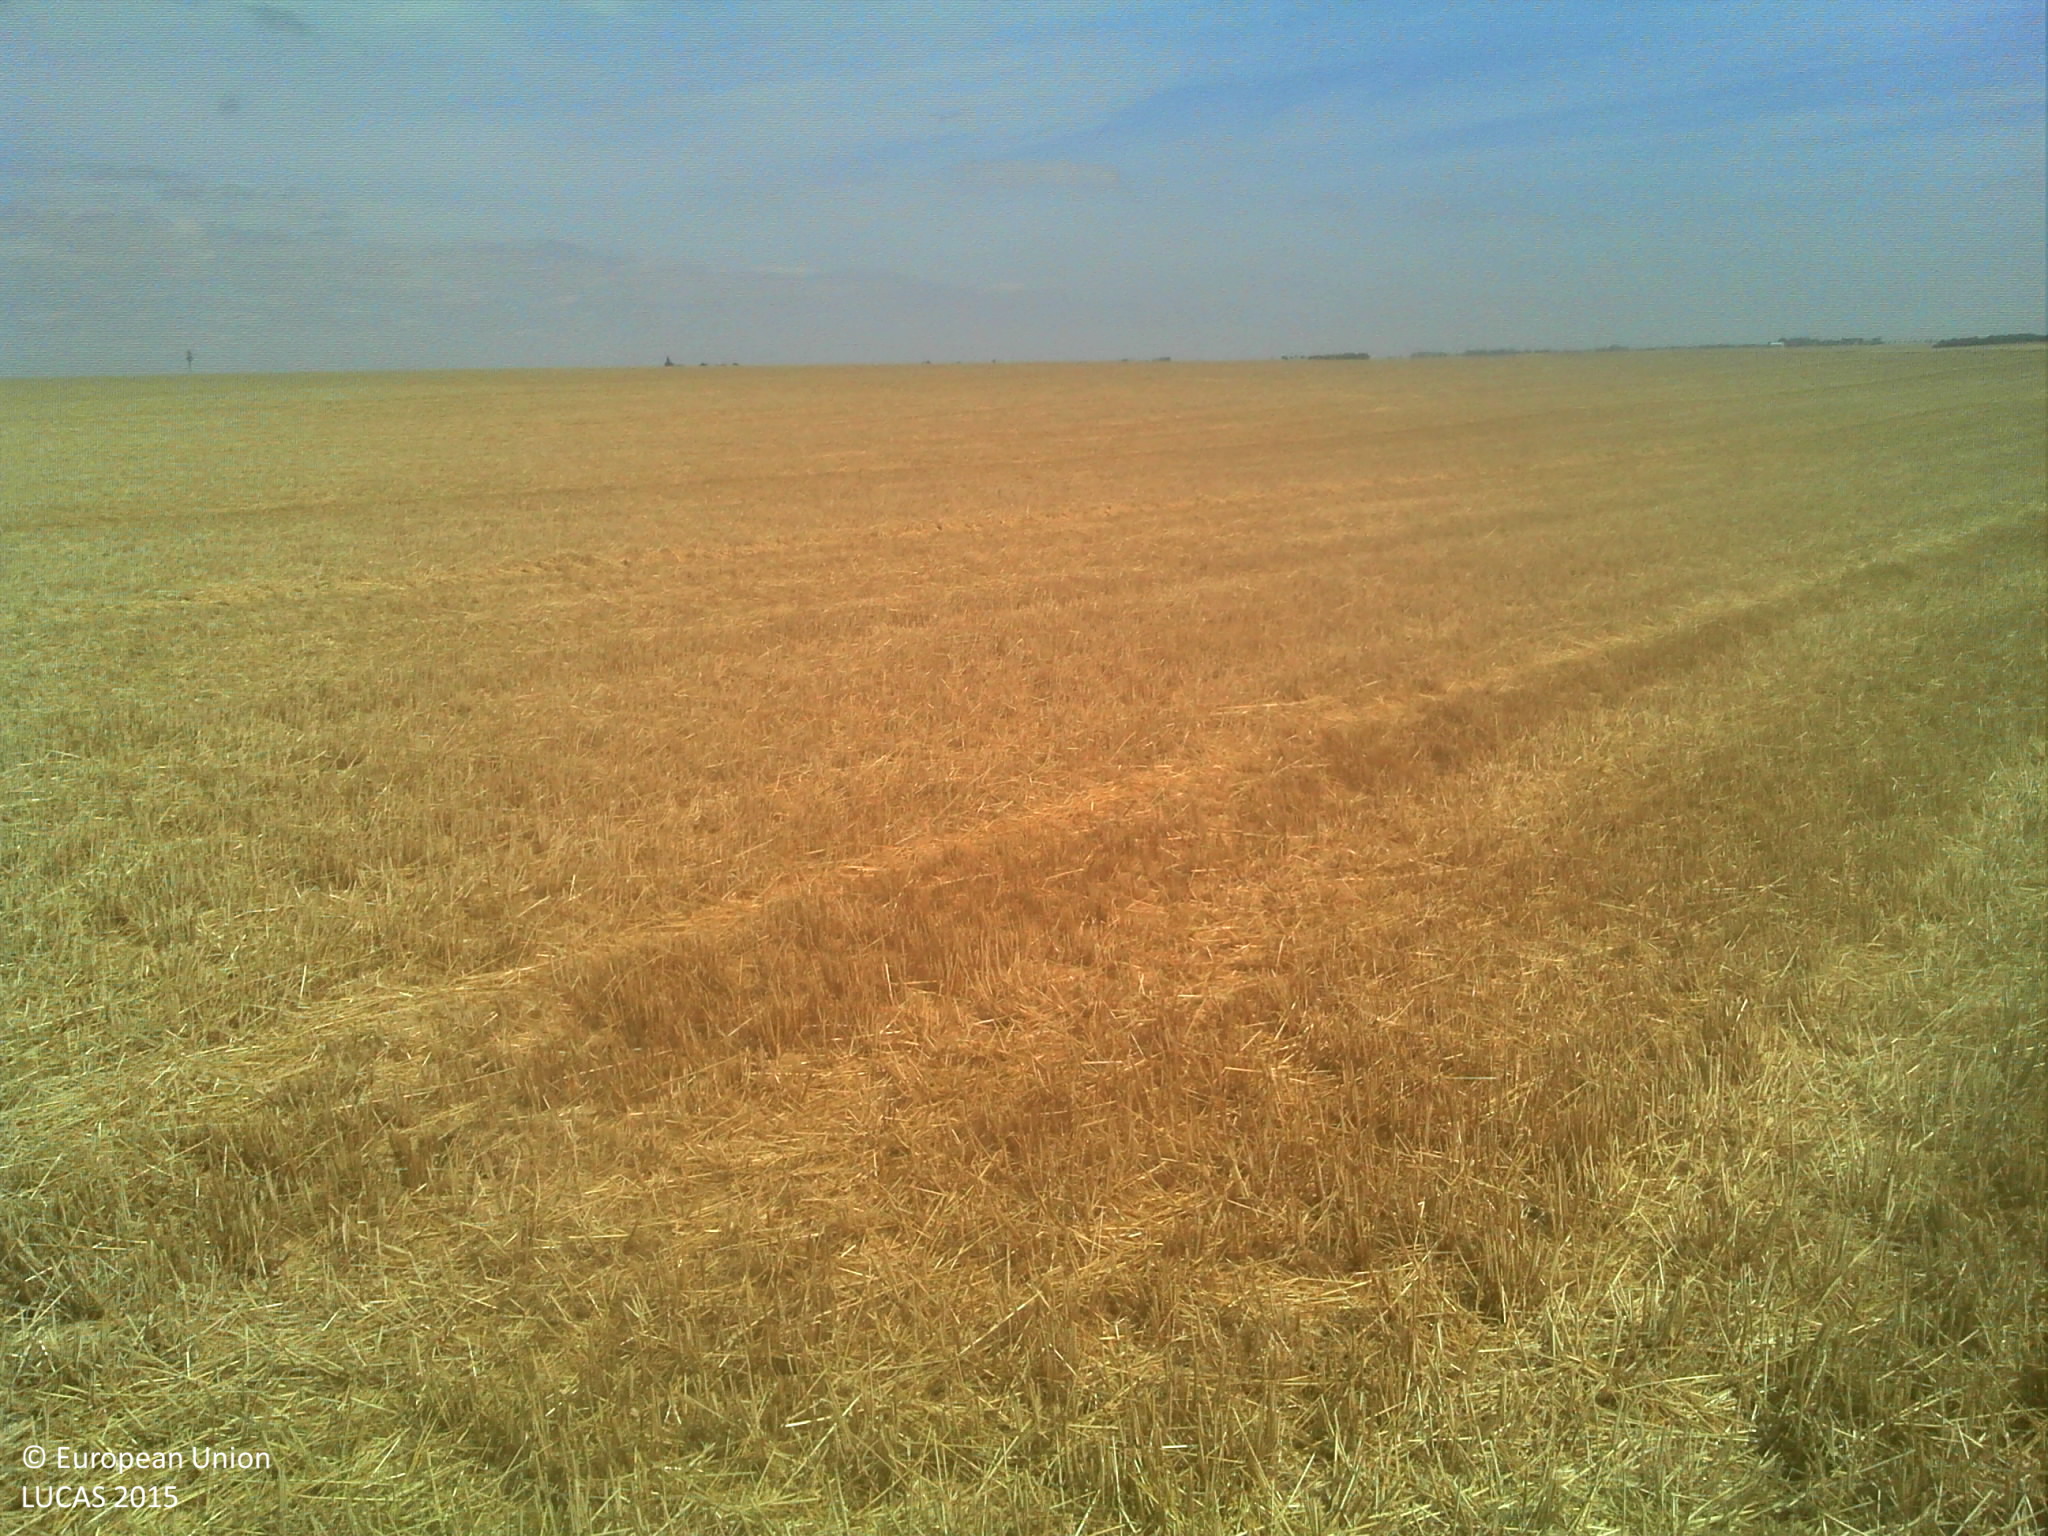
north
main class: Cropland
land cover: Durum wheat
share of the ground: > 75 %
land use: Agriculture (excluding fallow land and kitchen gardens)
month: July
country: FR
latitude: 47.7671
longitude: 1.4858
